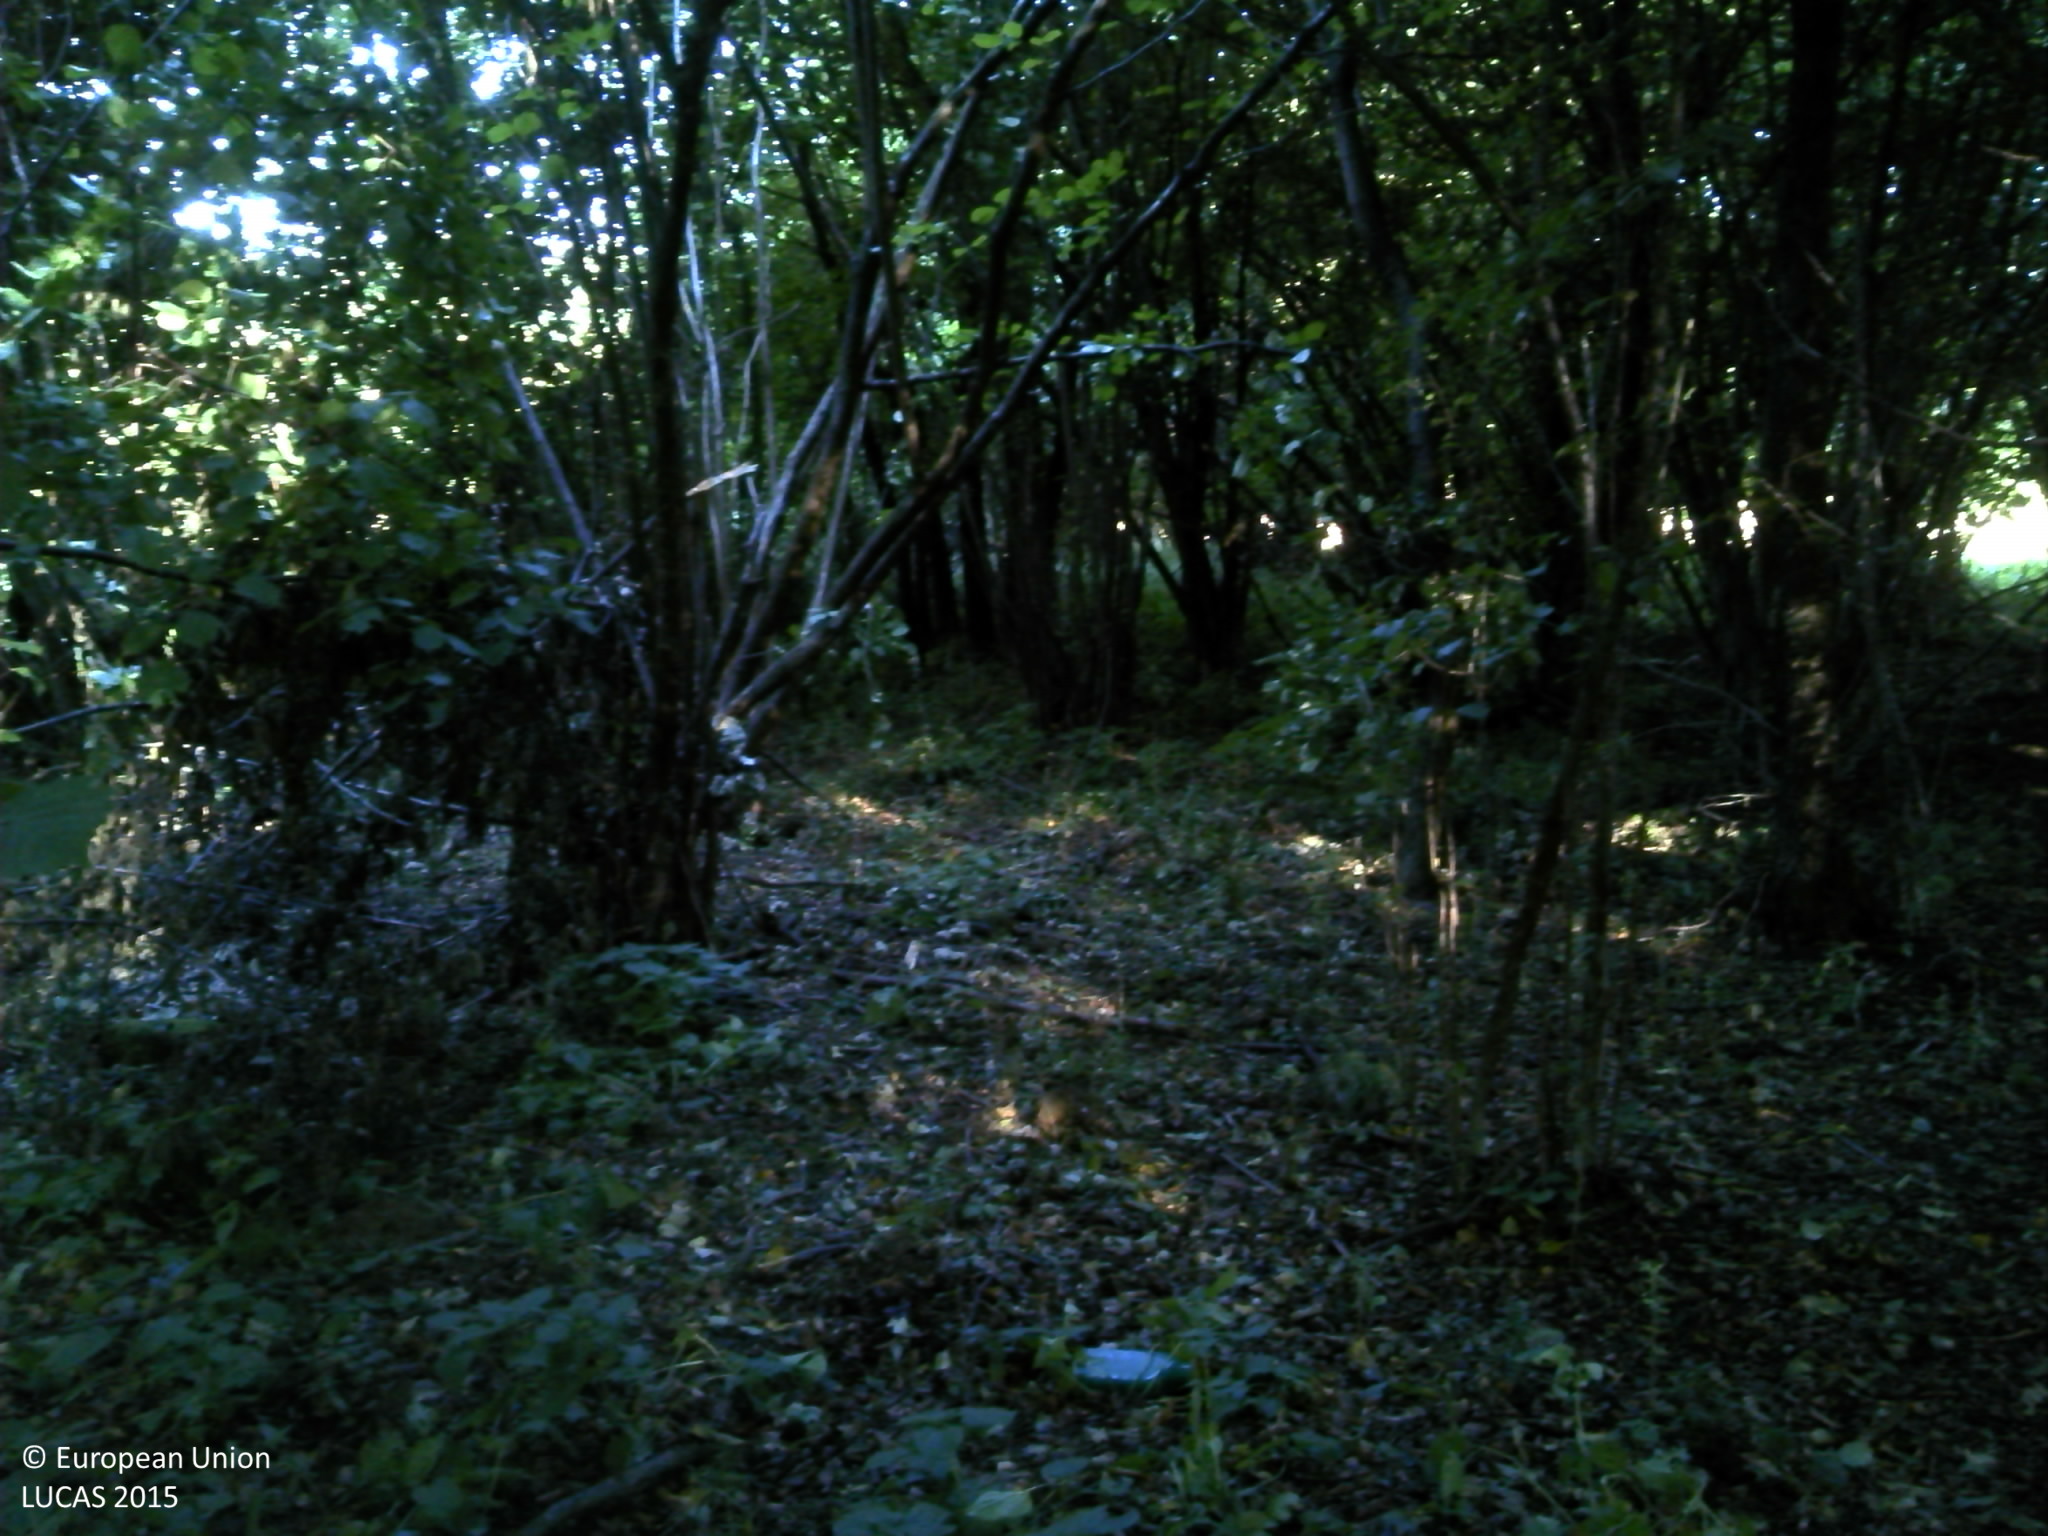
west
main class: Woodland
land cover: Broadleaved woodland
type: acidophilous oak and oak-birch forest
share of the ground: > 75 %
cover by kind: broadleaved forest trees 90 %, shrubs 5 %, herbaceous plants 5 %
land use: Forestry
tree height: > 5 m
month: July
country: HR
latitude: 45.9915
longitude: 16.7785
